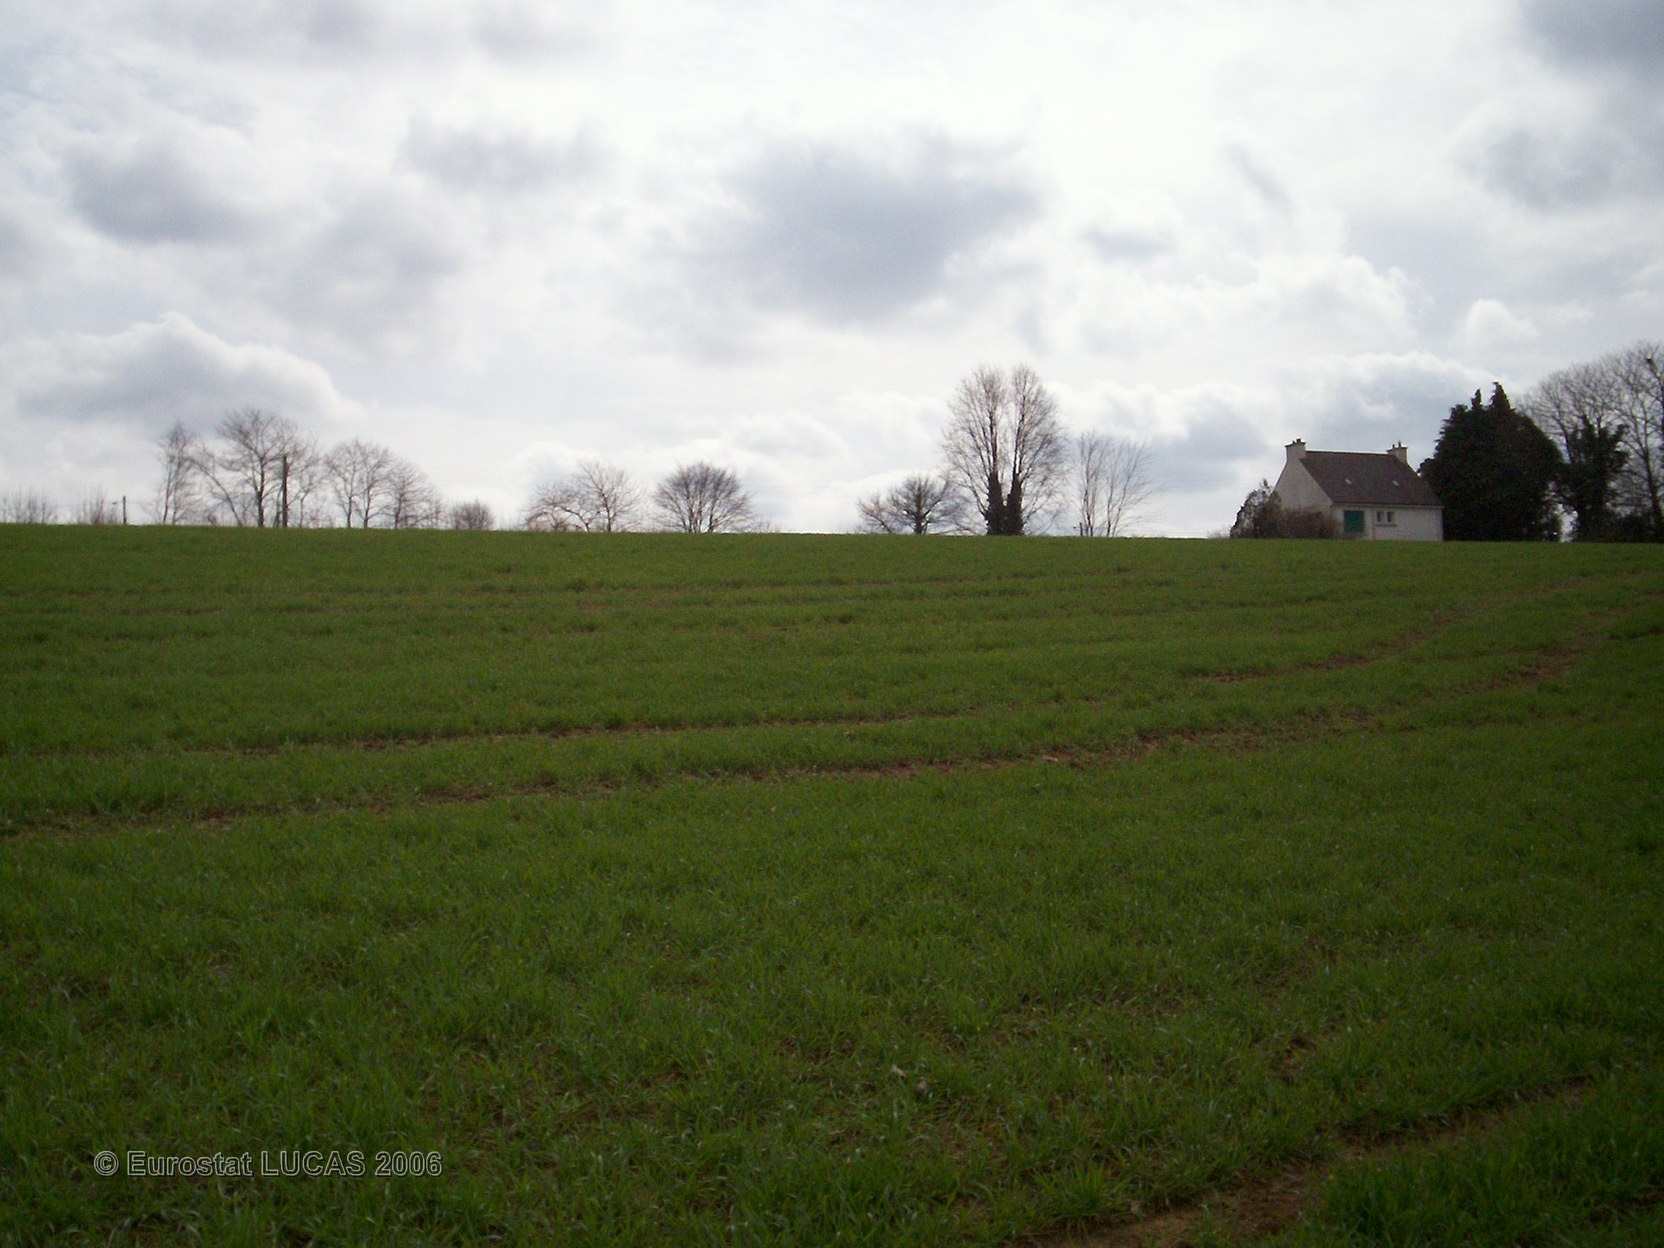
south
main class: Cropland
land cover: Common wheat
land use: Agriculture (excluding fallow land and kitchen gardens)
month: April
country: FR
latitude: 48.1262
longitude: -3.5813
